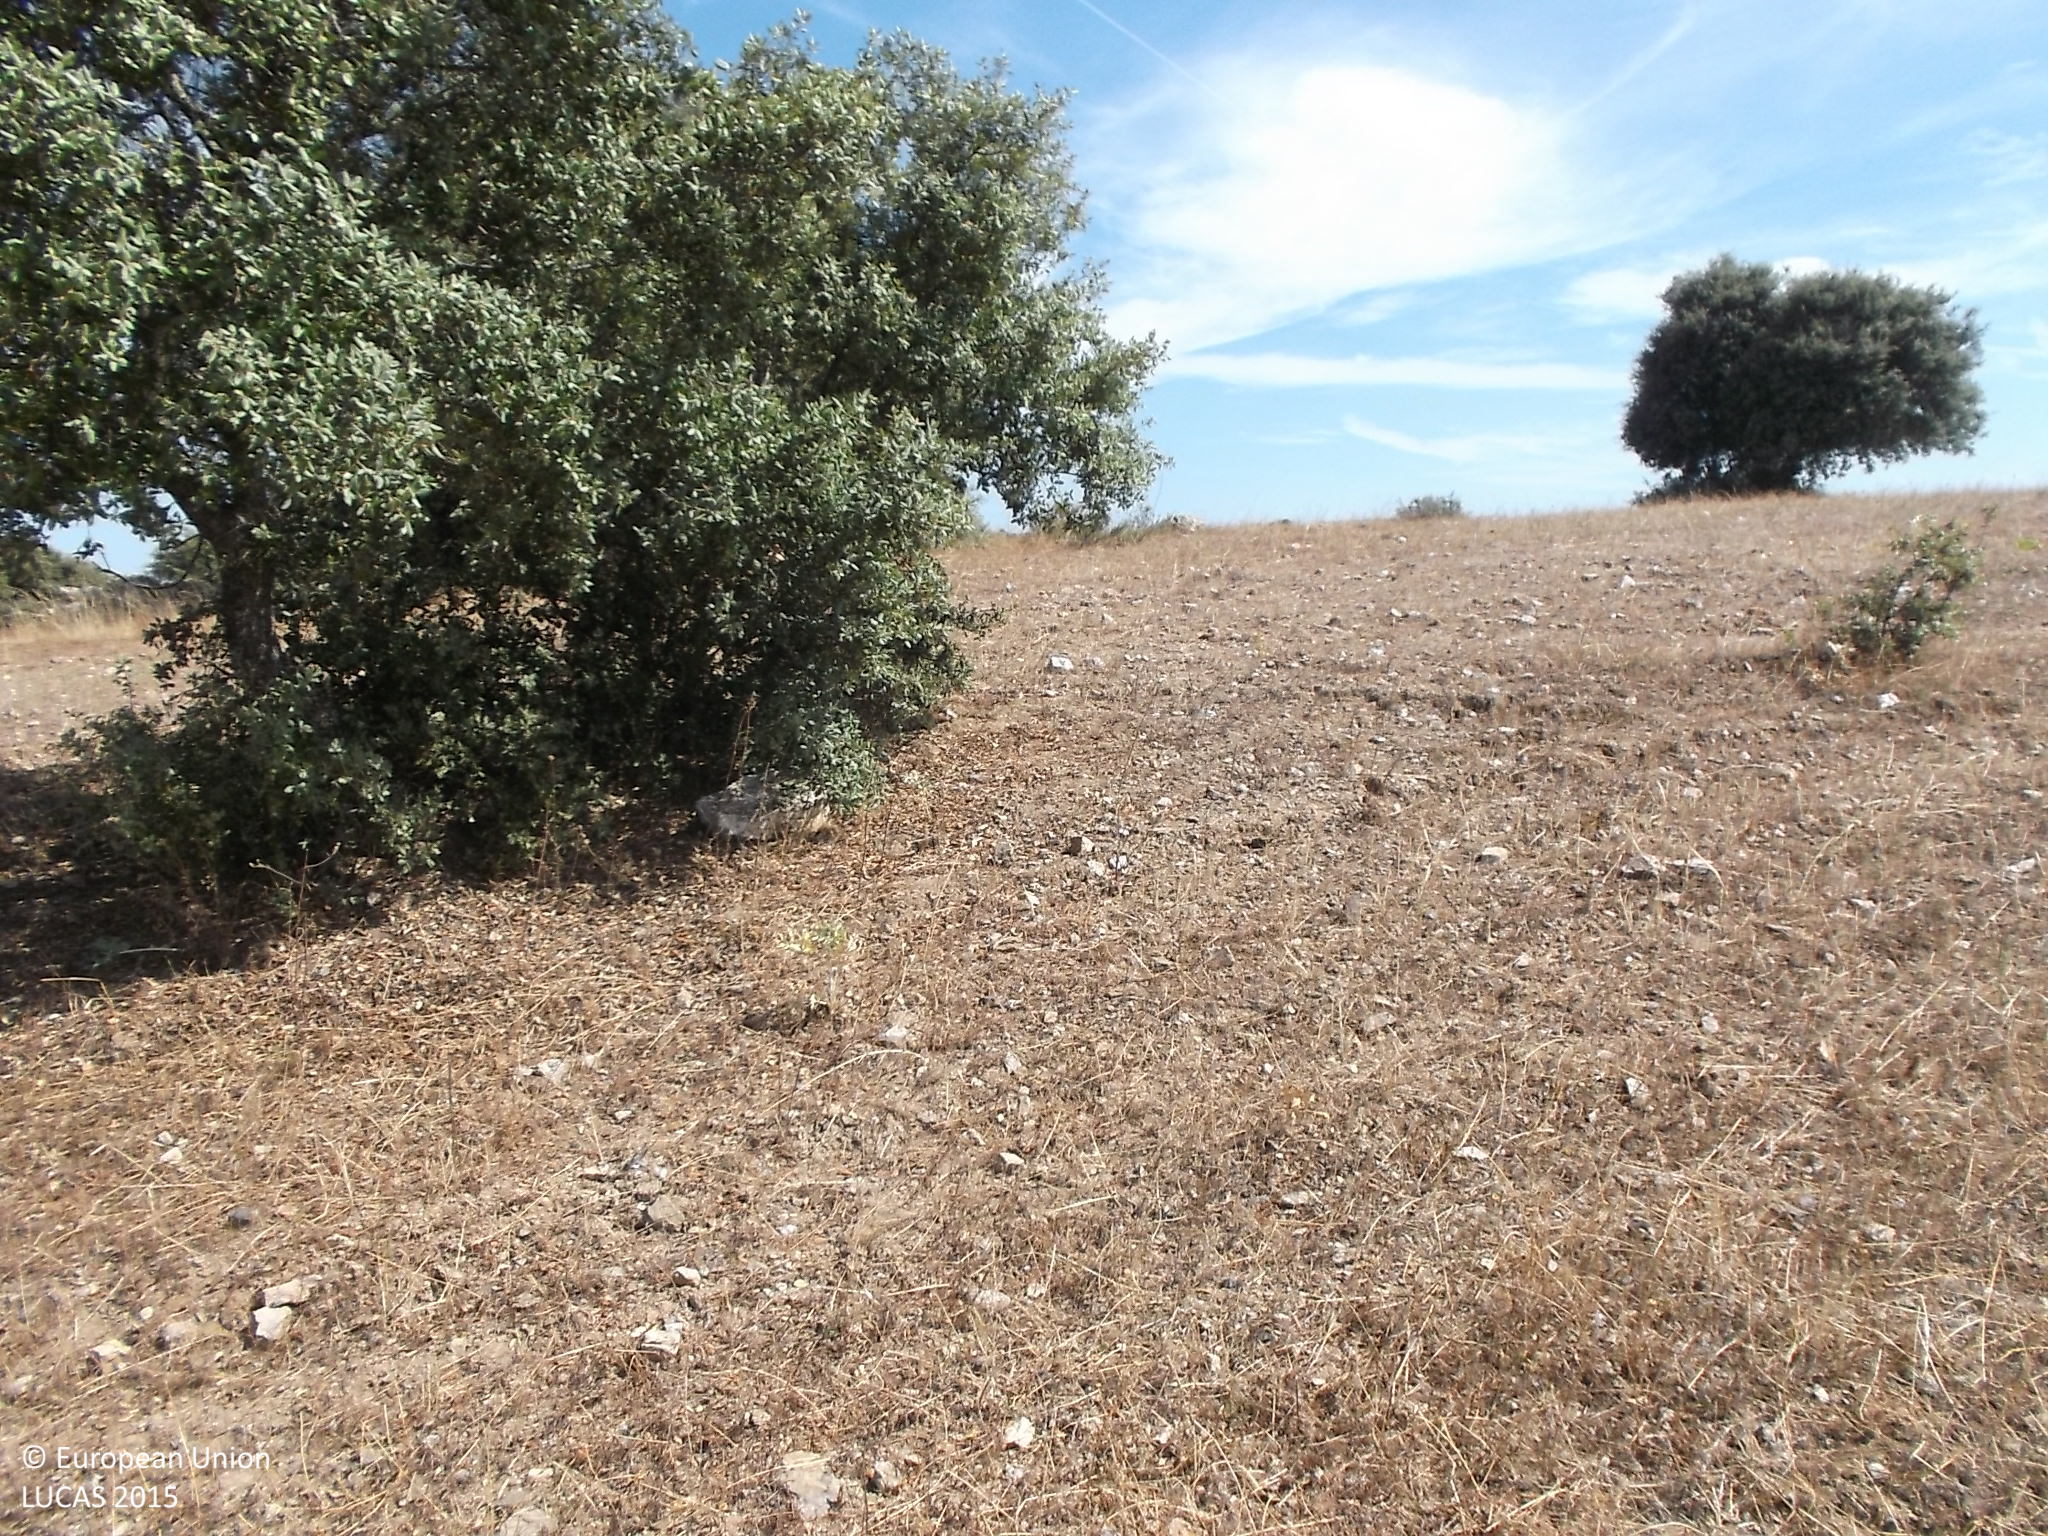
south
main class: Grassland
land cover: Grassland without tree/shrub cover
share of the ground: > 75 %
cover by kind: herbaceous plants 95 %, shrubs 5 %
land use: Agriculture (excluding fallow land and kitchen gardens)
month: July
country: ES
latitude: 40.9907
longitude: -6.8517
